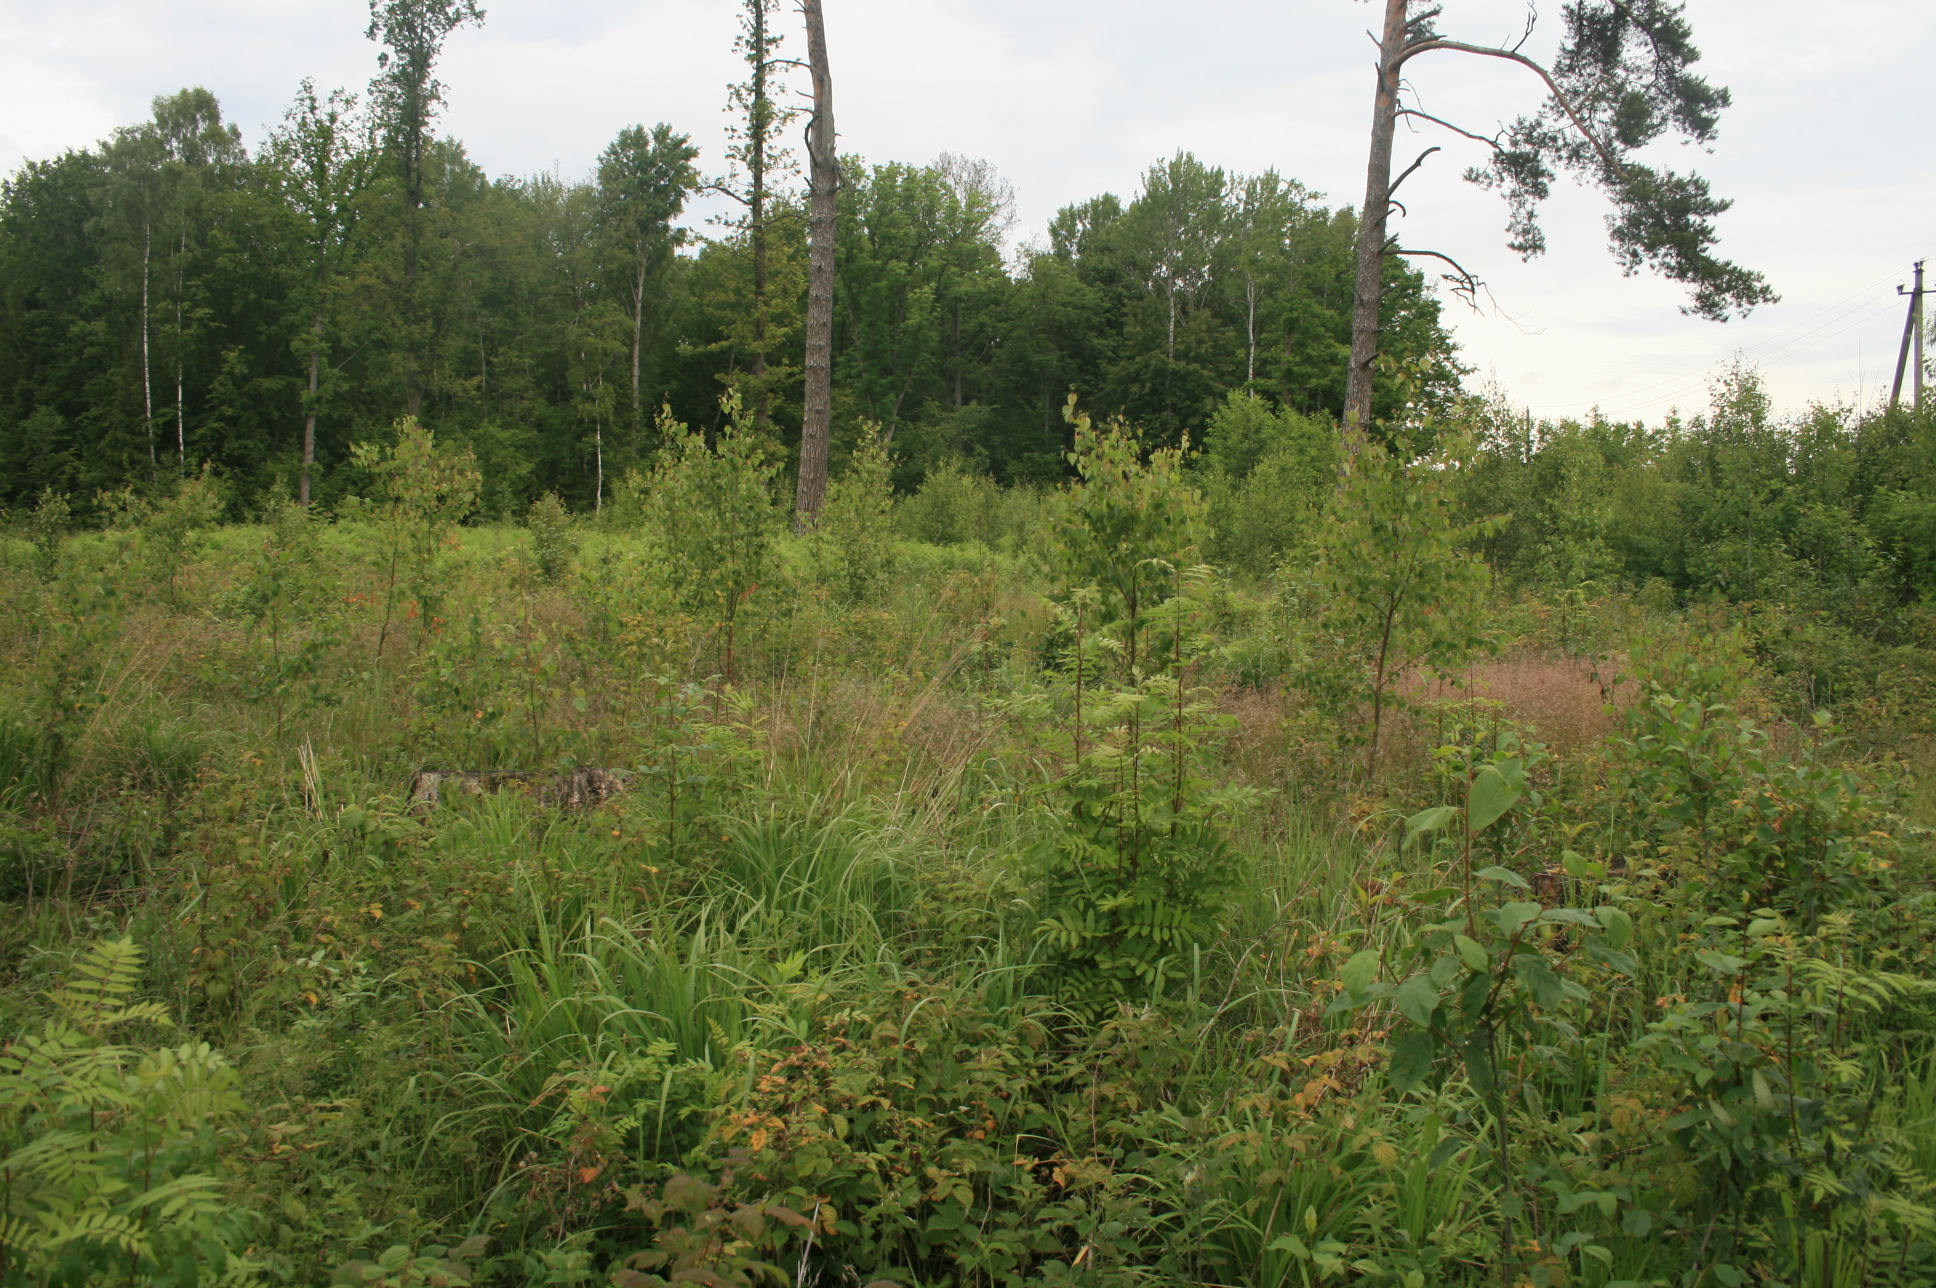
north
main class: Woodland
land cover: Broadleaved woodland
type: non-riverine alder, birch or aspen forest
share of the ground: 25 - 50 %
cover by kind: shrubs 50 %, broadleaved forest trees 30 %, coniferous forest trees 10 %, herbaceous plants 10 %
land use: Forestry
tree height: < 5 m
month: June
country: LT
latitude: 55.2289
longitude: 22.1150
